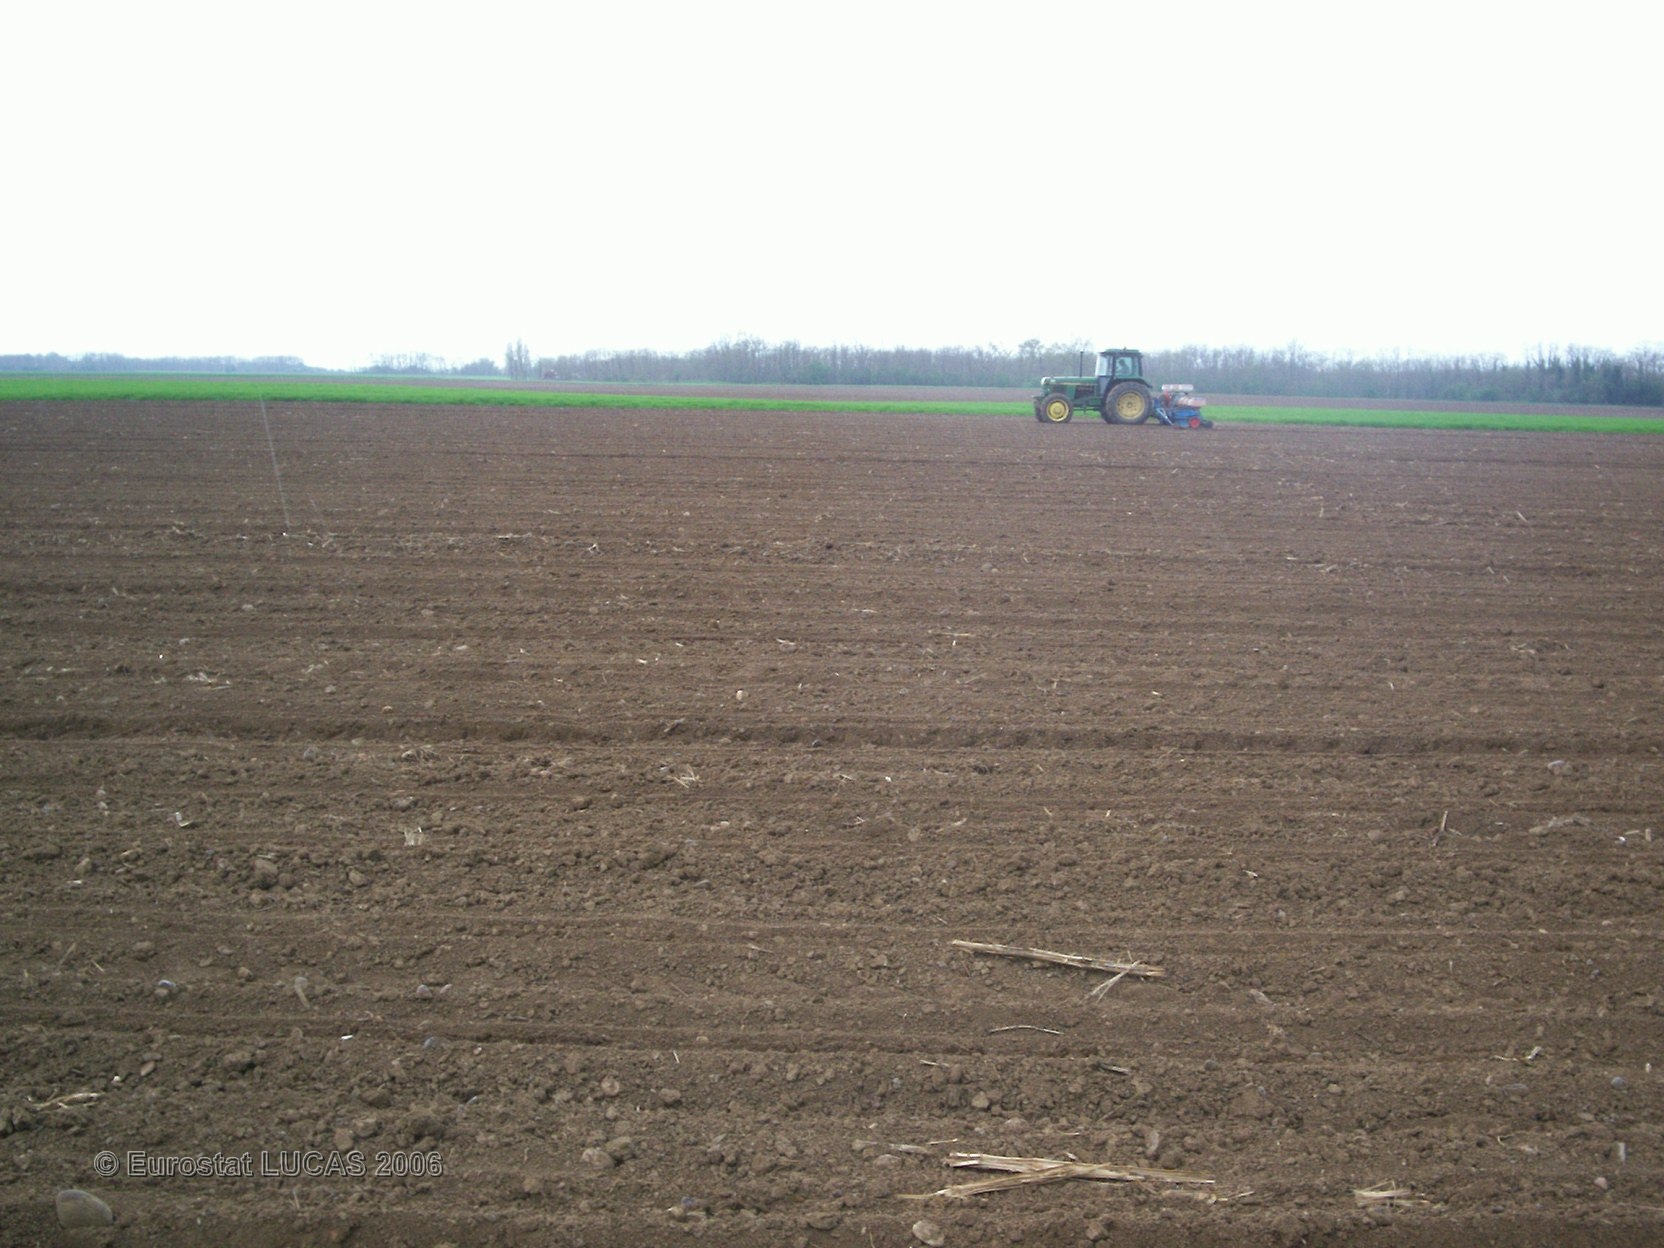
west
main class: Cropland
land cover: Maize
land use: Agriculture (excluding fallow land and kitchen gardens)
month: April
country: FR
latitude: 47.9772
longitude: 7.4157
